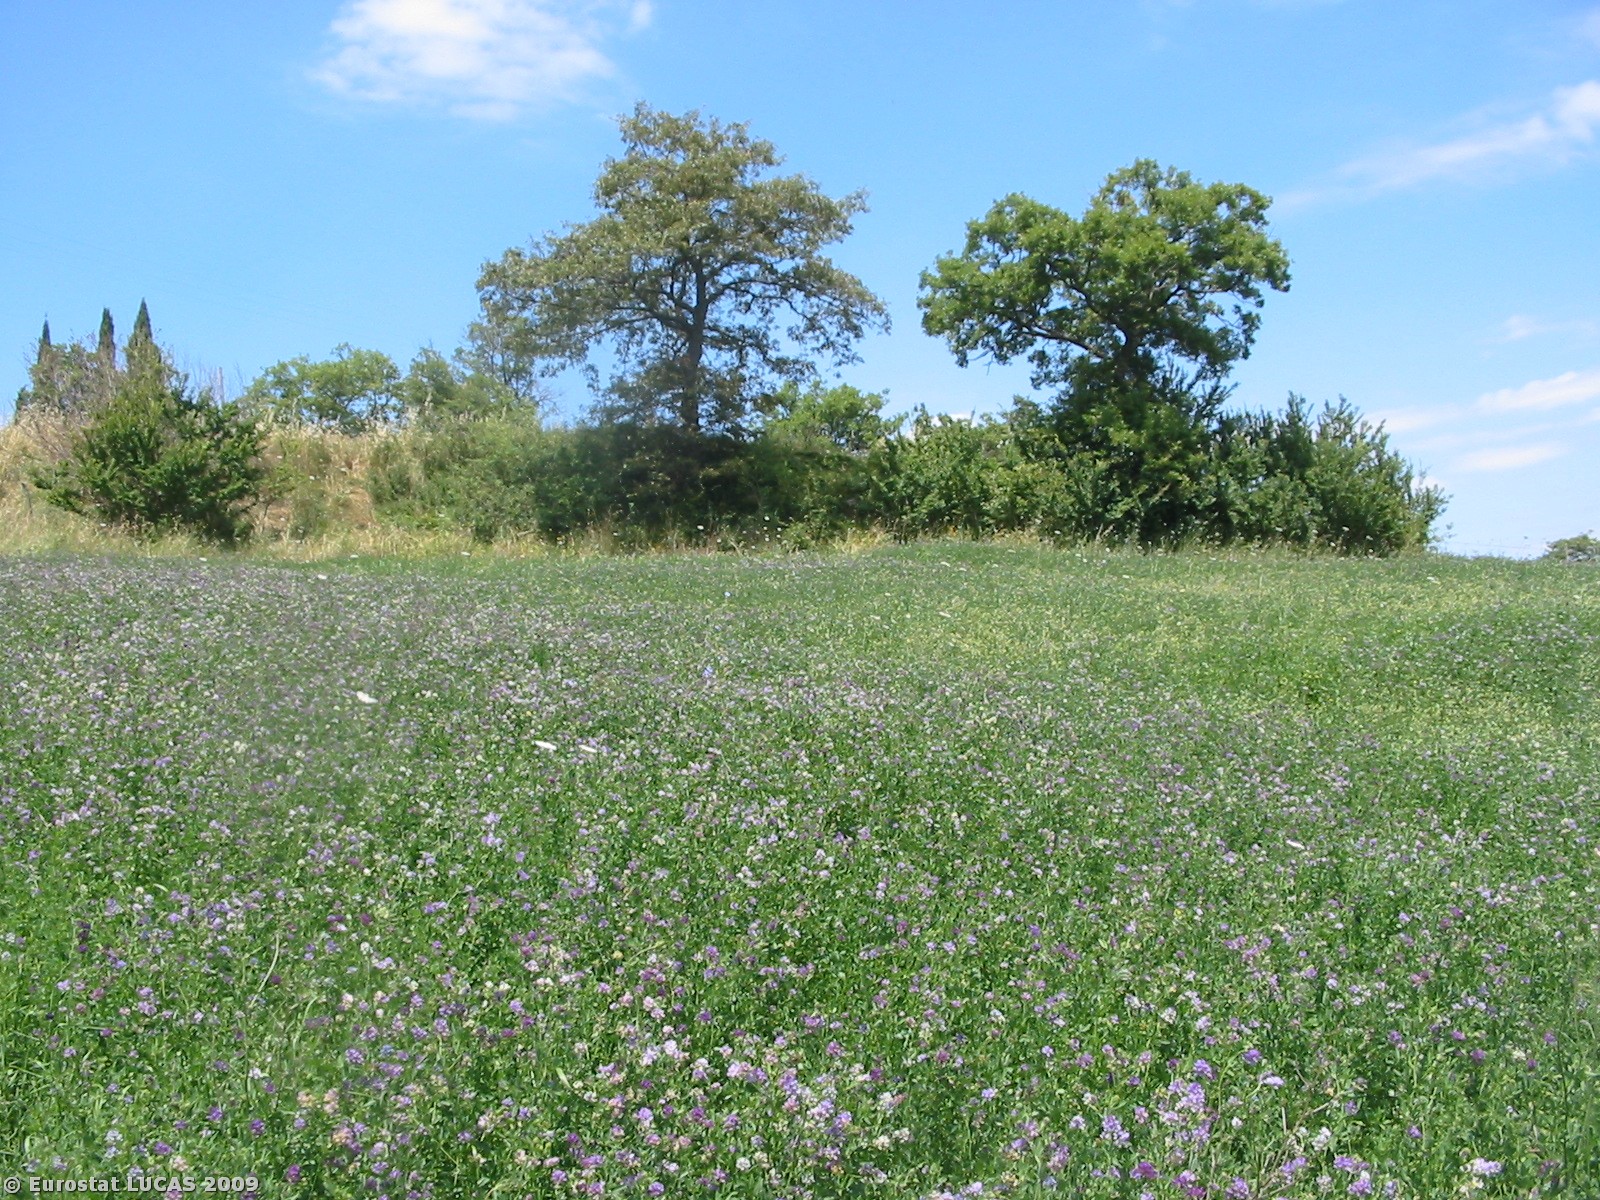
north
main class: Cropland
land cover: Lucerne
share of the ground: > 75 %
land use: Agriculture (excluding fallow land and kitchen gardens)
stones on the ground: 10 - 25 %
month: July
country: IT
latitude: 42.9472
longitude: 11.6739
